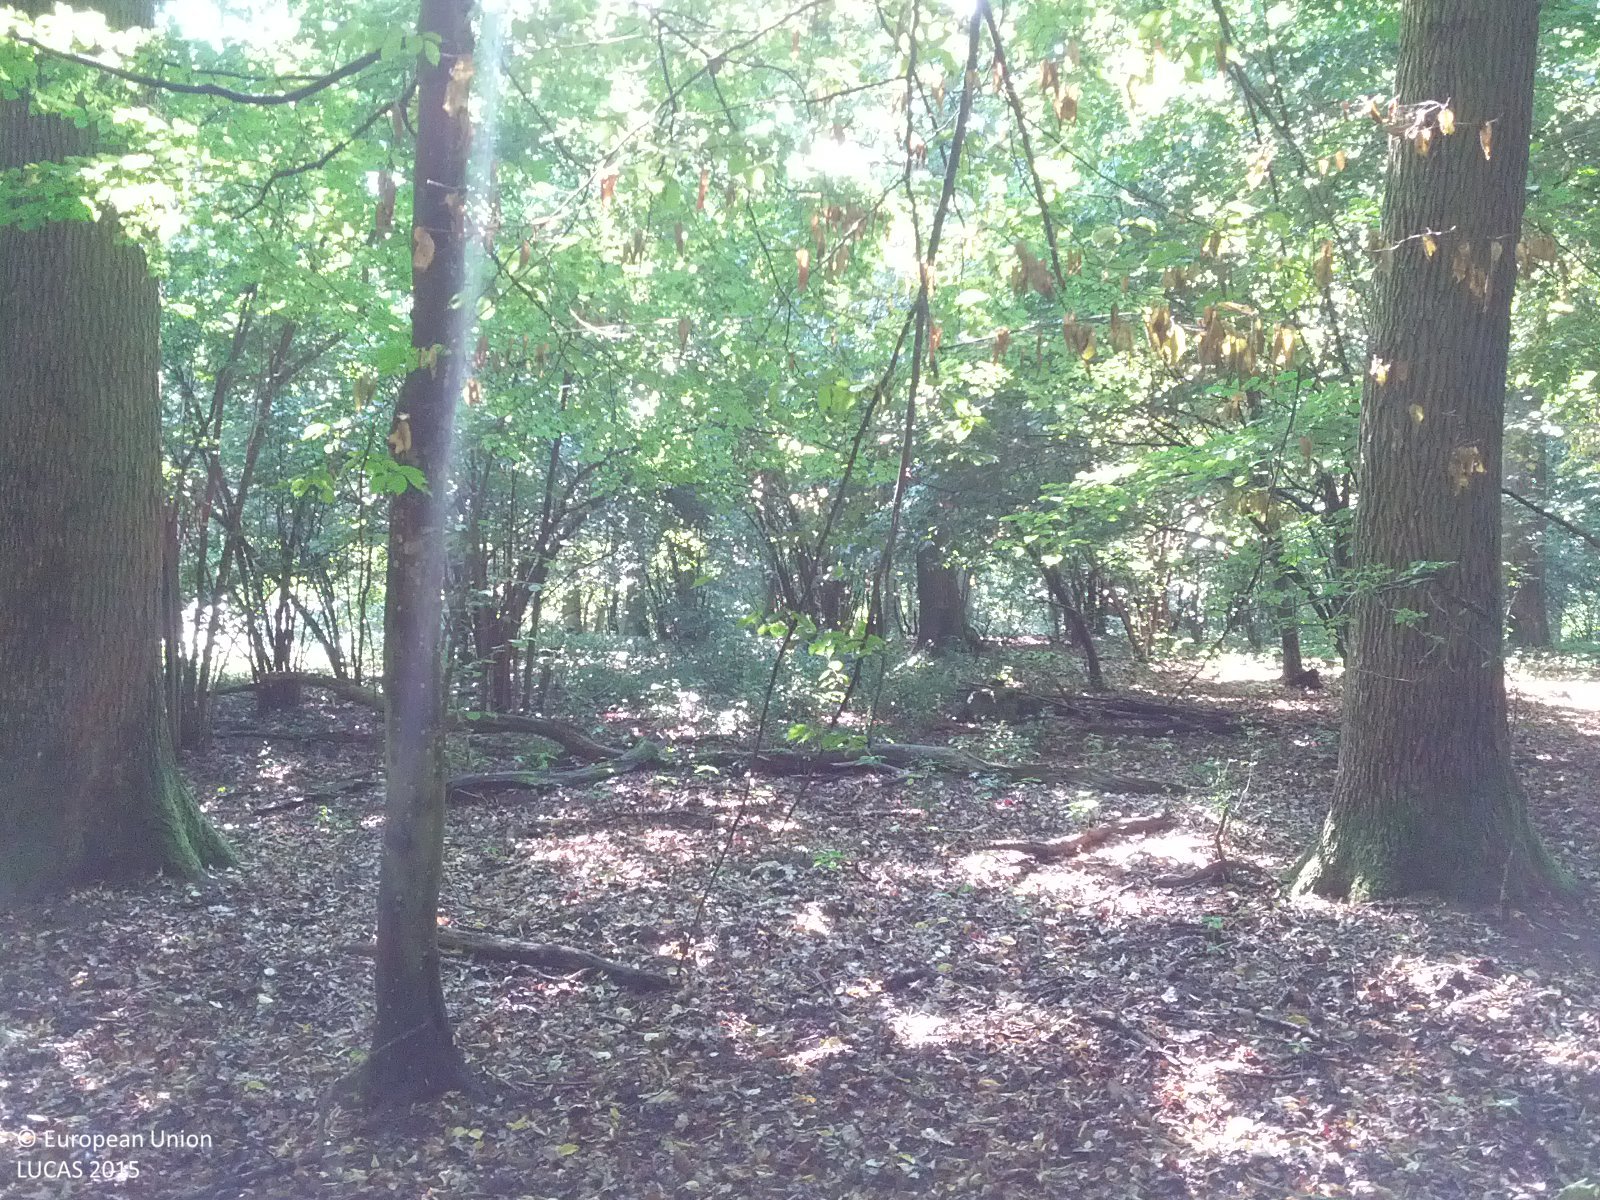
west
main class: Woodland
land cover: Broadleaved woodland
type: beech forest
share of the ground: > 75 %
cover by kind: broadleaved forest trees 100 %
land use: Forestry
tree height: > 5 m
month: July
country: AT
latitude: 48.5858
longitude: 16.2820
